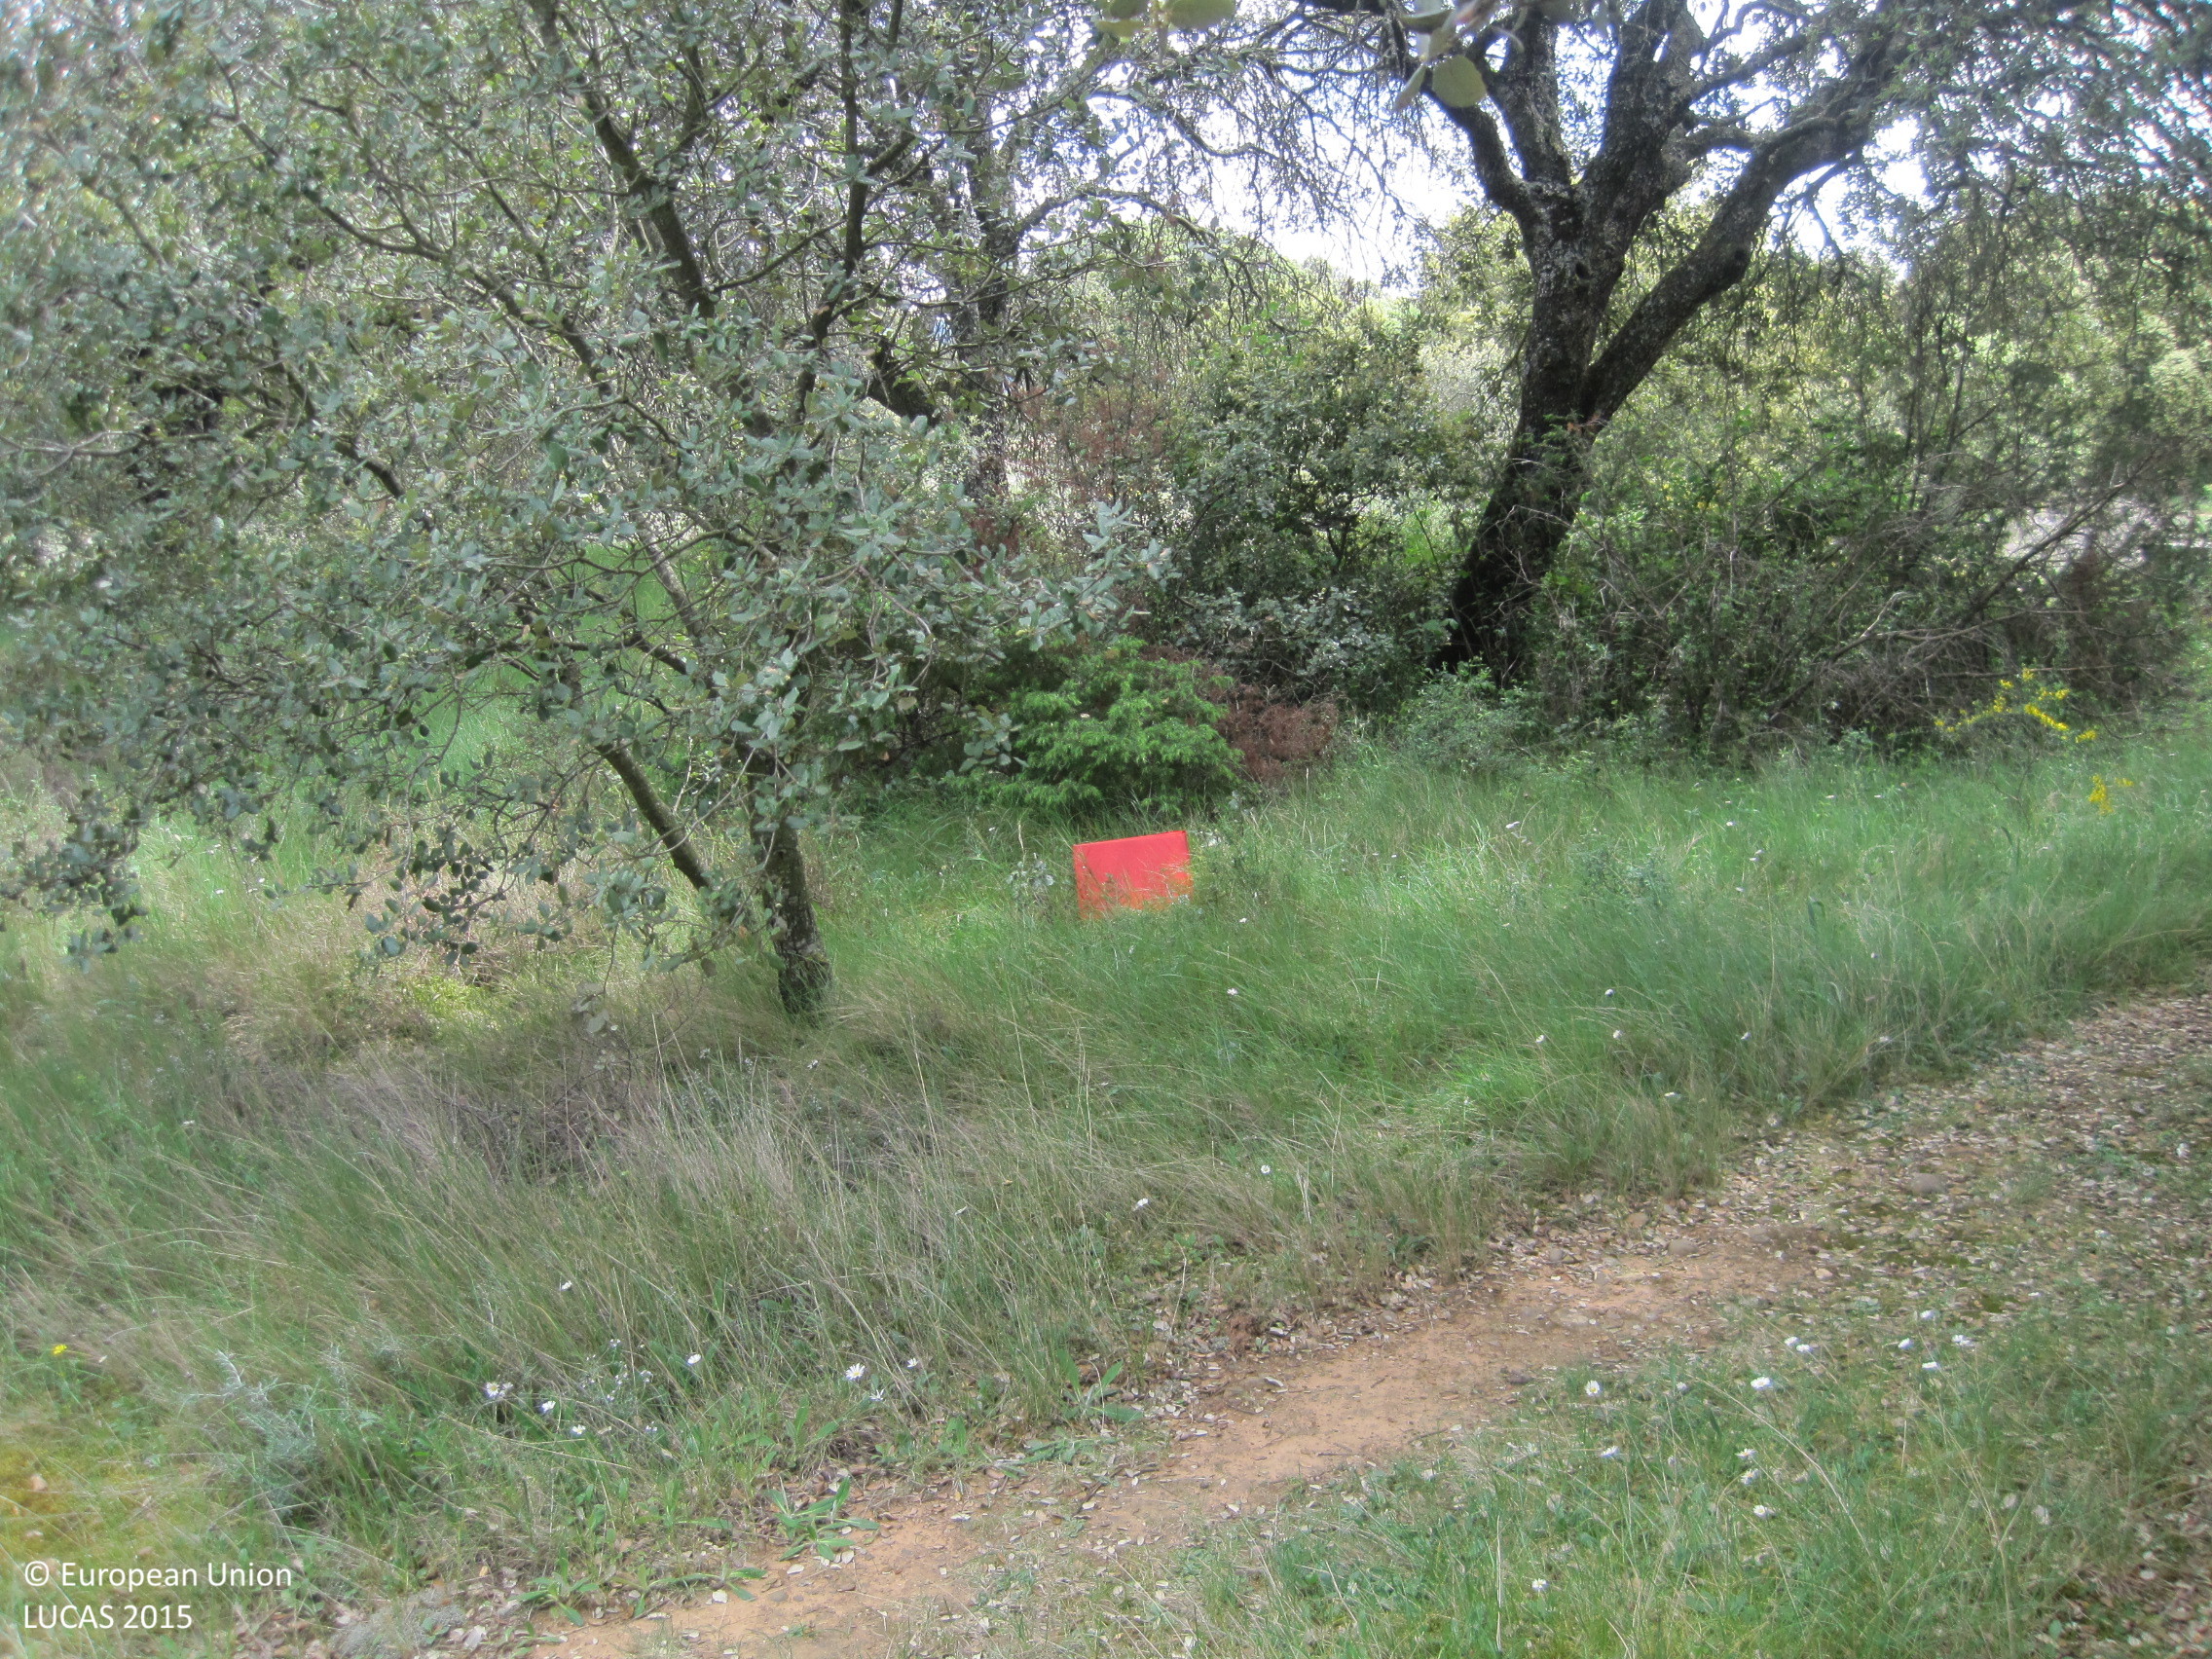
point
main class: Woodland
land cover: Broadleaved woodland
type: acidophilous oak and oak-birch forest
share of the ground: 50 - 75 %
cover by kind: broadleaved forest trees 50 %, herbaceous plants 35 %, shrubs 10 %, unconsolidated bare surface 5 %
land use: Semi-natural and natural areas not in use
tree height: > 5 m
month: May
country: ES
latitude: 42.7151
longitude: -1.7491
